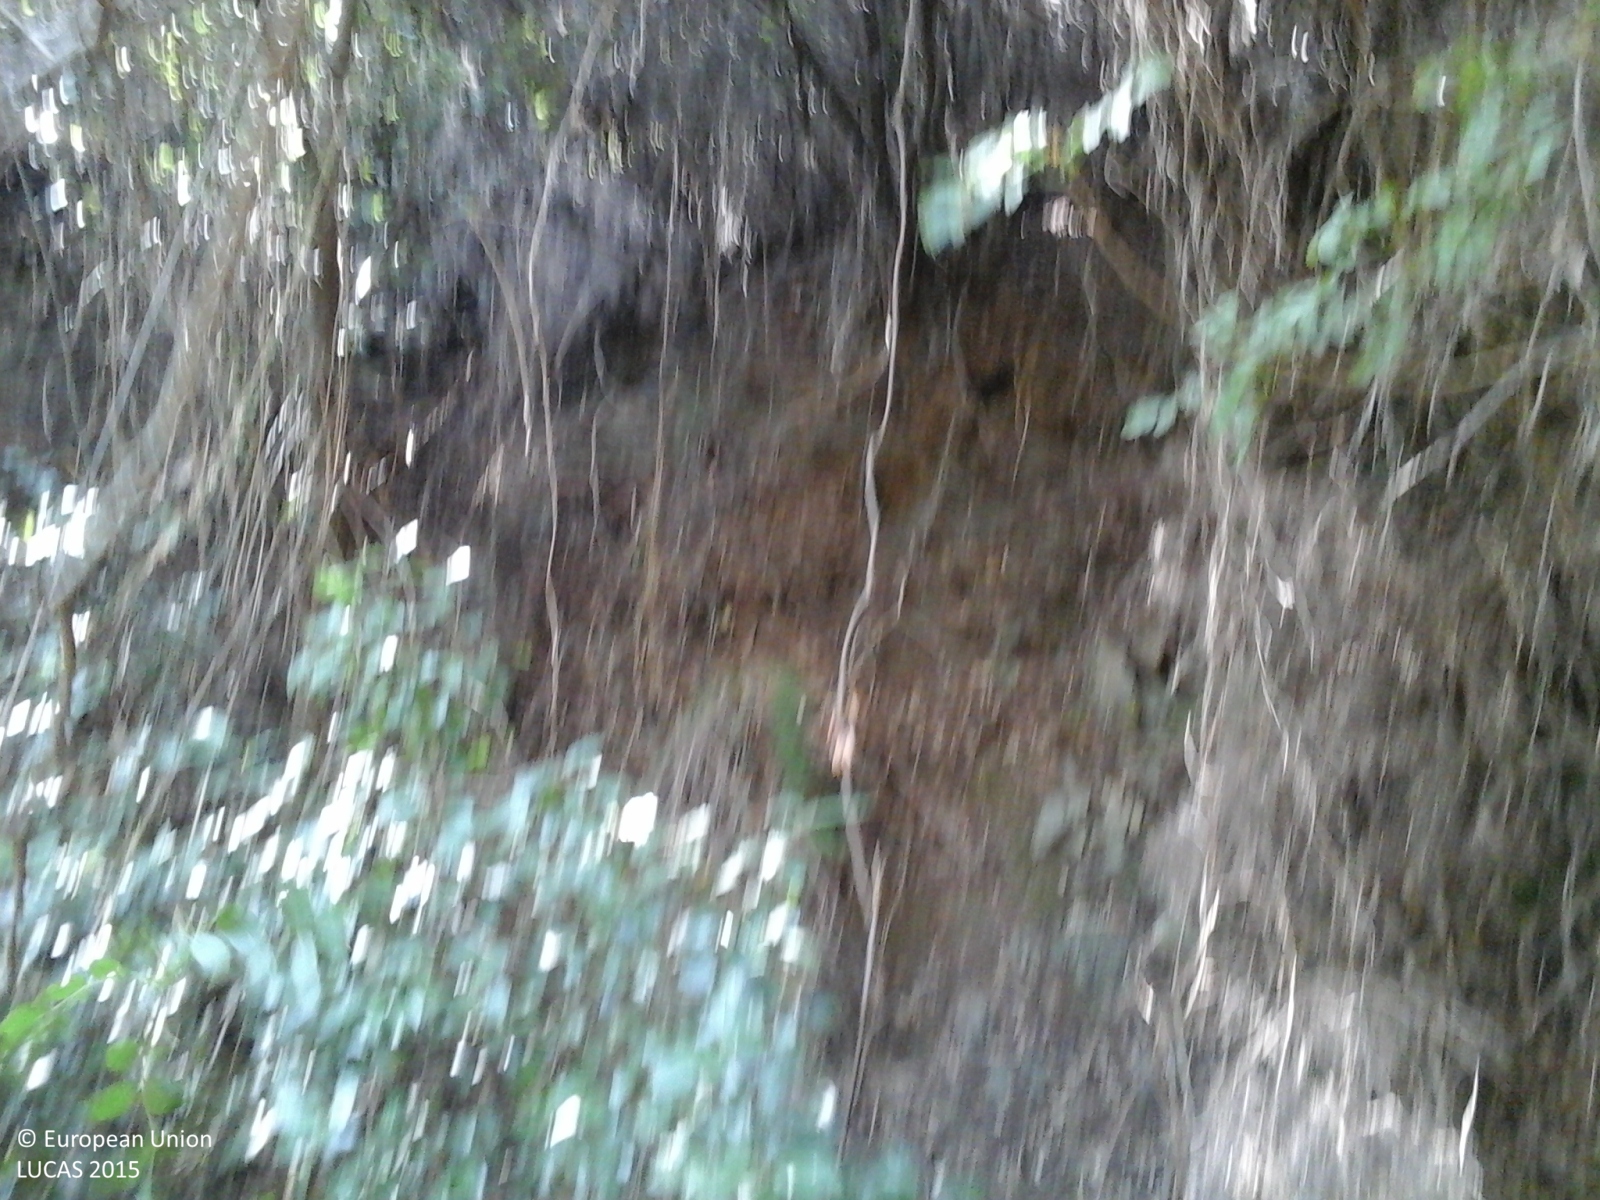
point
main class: Woodland
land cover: Broadleaved woodland
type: thermophilous deciduous forest
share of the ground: > 75 %
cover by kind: broadleaved forest trees 80 %, shrubs 10 %, herbaceous plants 10 %
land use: Semi-natural and natural areas not in use
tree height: > 5 m
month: September
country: IT
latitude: 44.3395
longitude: 8.4858
